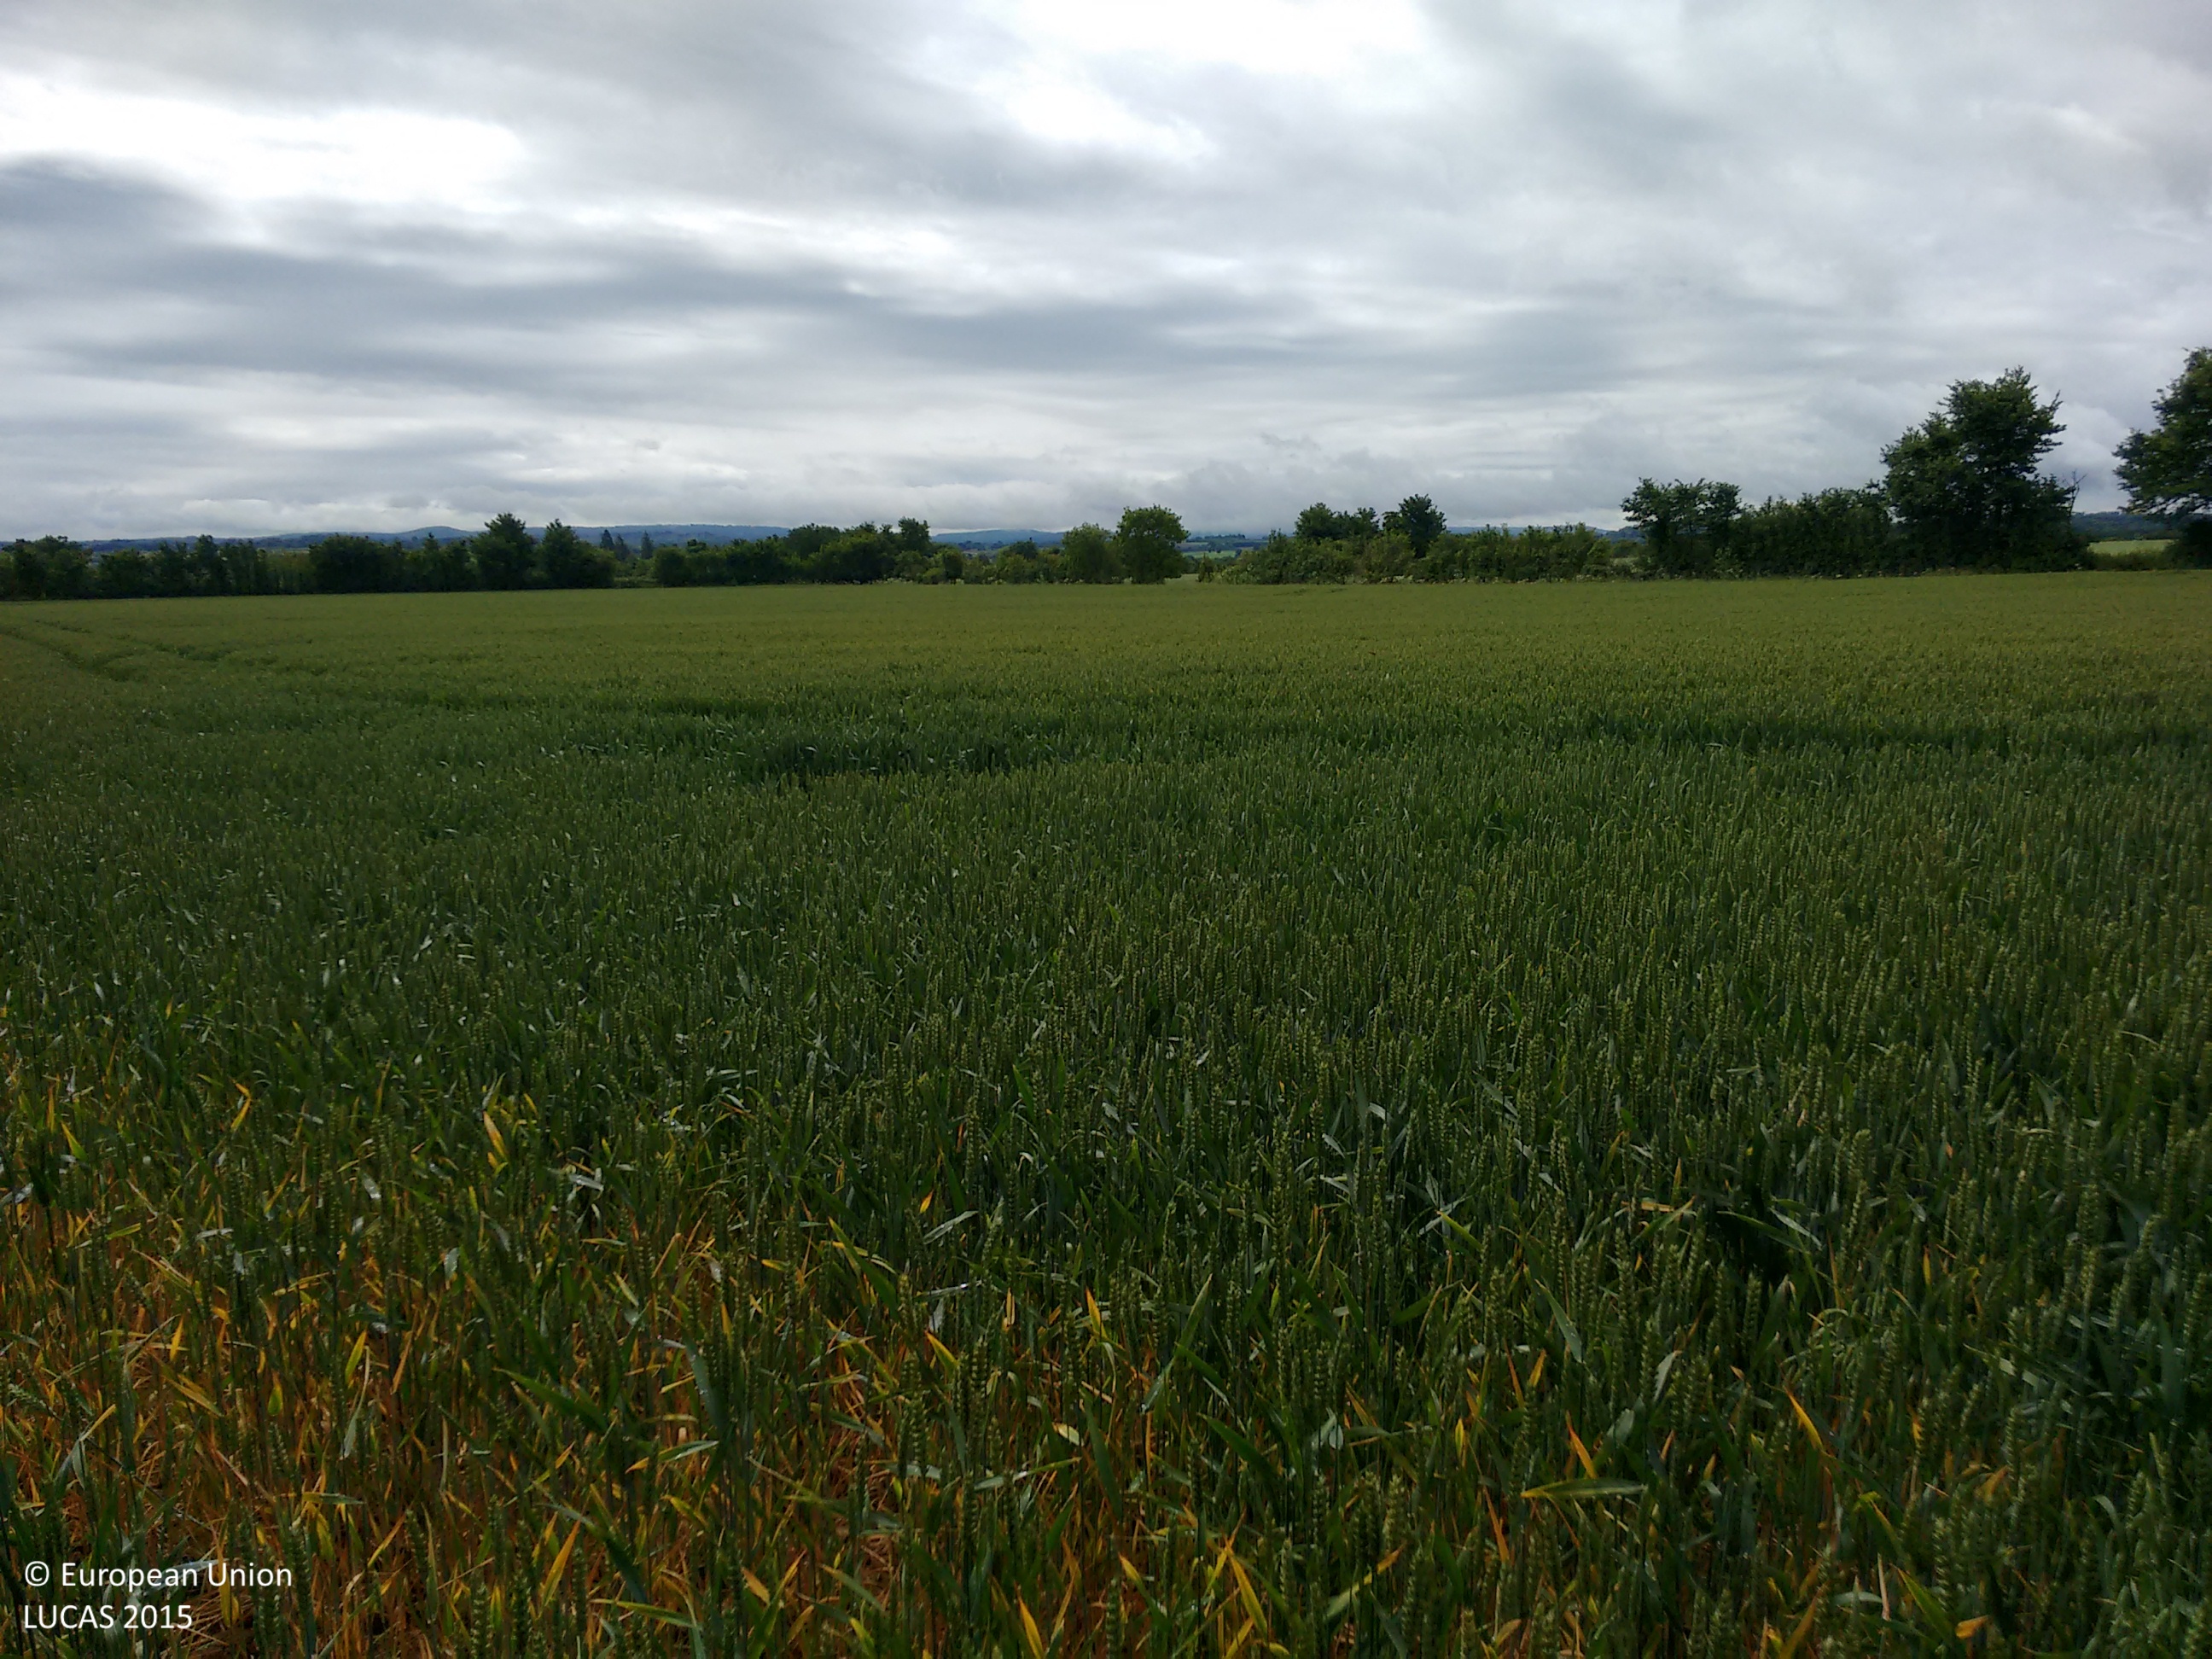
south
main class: Cropland
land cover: Common wheat
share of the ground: > 75 %
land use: Agriculture (excluding fallow land and kitchen gardens)
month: June
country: GB
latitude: 51.2985
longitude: -2.2970
